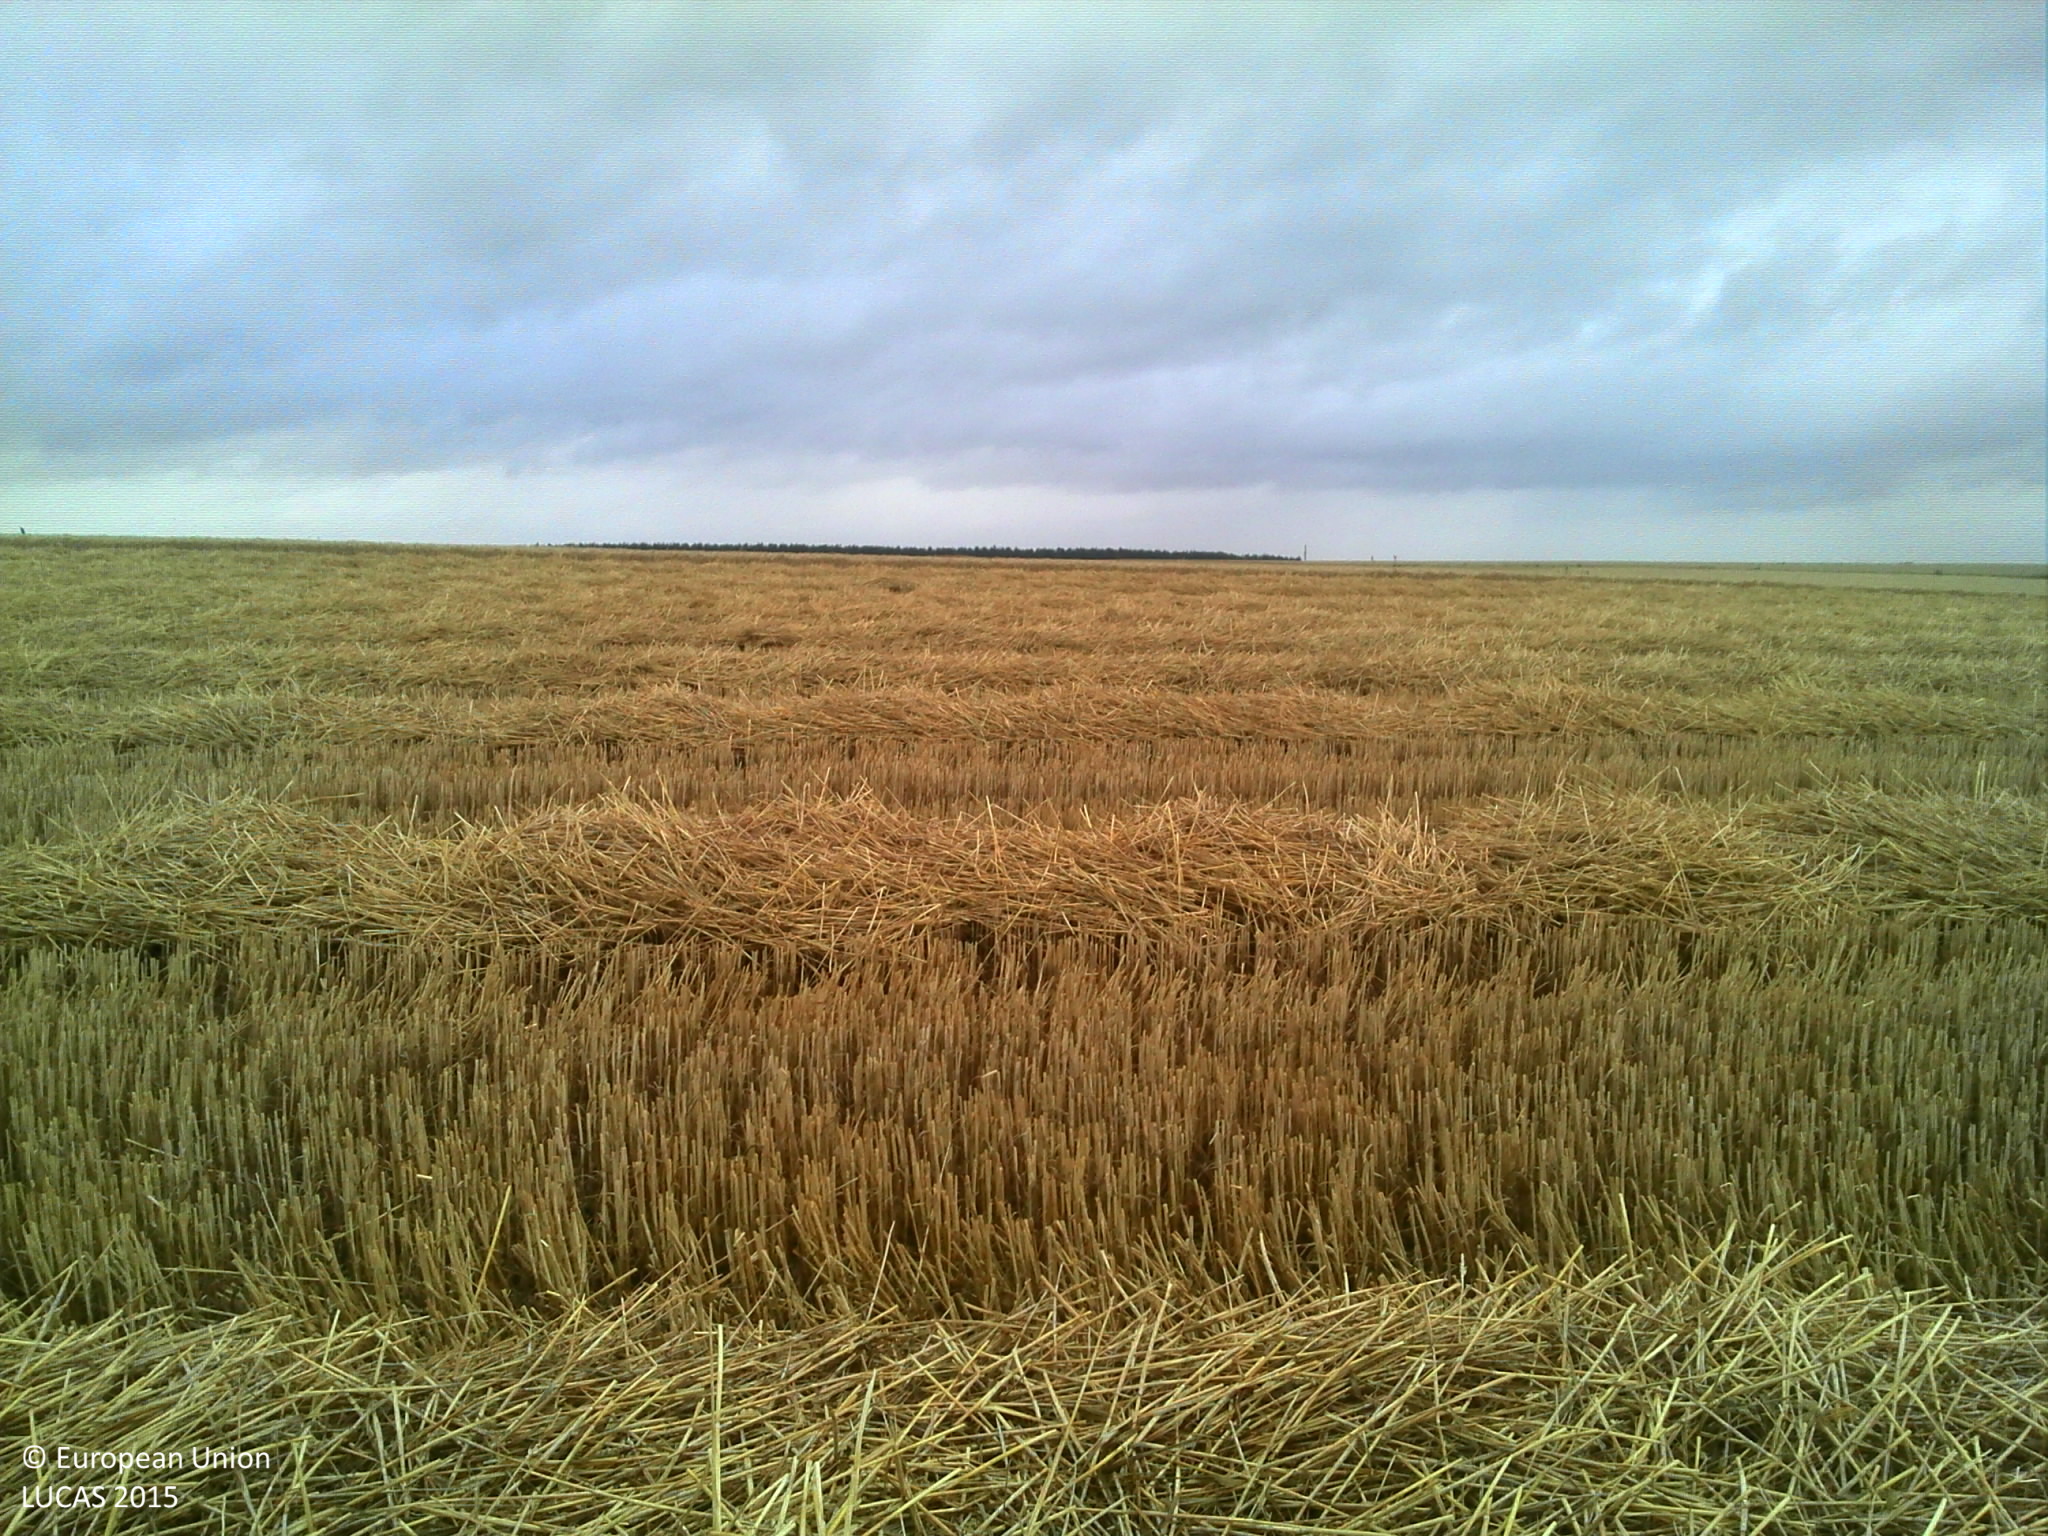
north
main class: Cropland
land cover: Common wheat
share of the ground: > 75 %
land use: Agriculture (excluding fallow land and kitchen gardens)
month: July
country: FR
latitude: 49.8444
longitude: 2.4643
